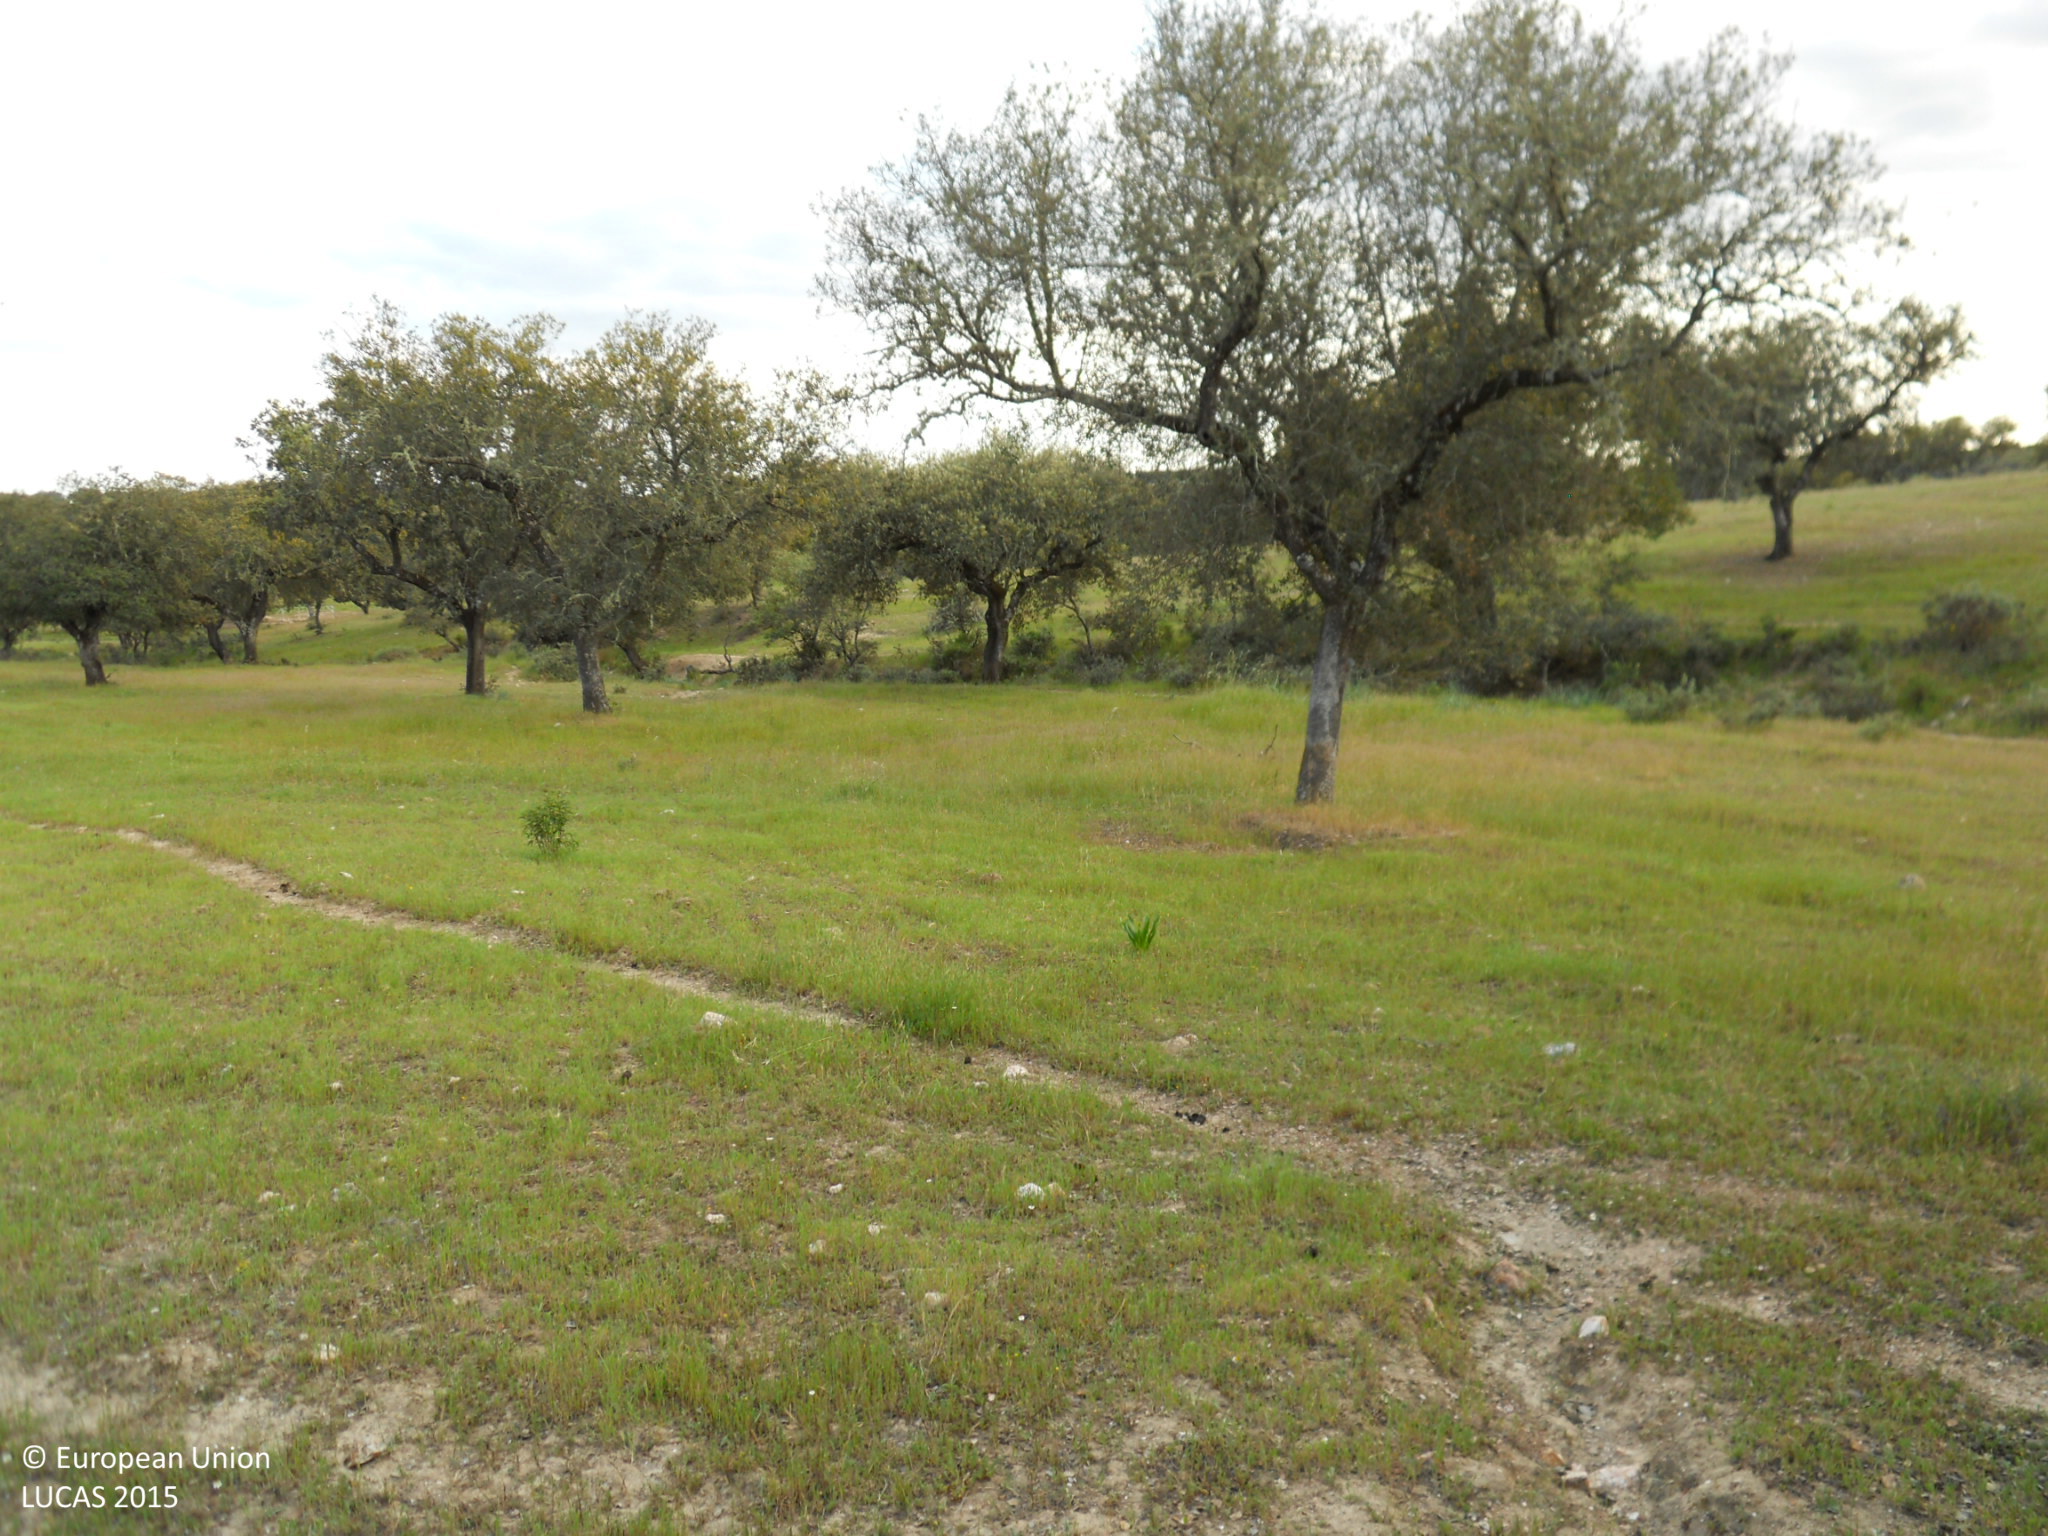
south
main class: Woodland
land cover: Broadleaved woodland
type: broadleaved evergreen forest
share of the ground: > 75 %
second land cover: Grassland without tree/shrub cover
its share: > 75 %
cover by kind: broadleaved forest trees 95 %, herbaceous plants 5 %
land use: Forestry
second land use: Agriculture (excluding fallow land and kitchen gardens)
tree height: > 5 m
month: April
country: ES
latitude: 39.2329
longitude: -6.7892
